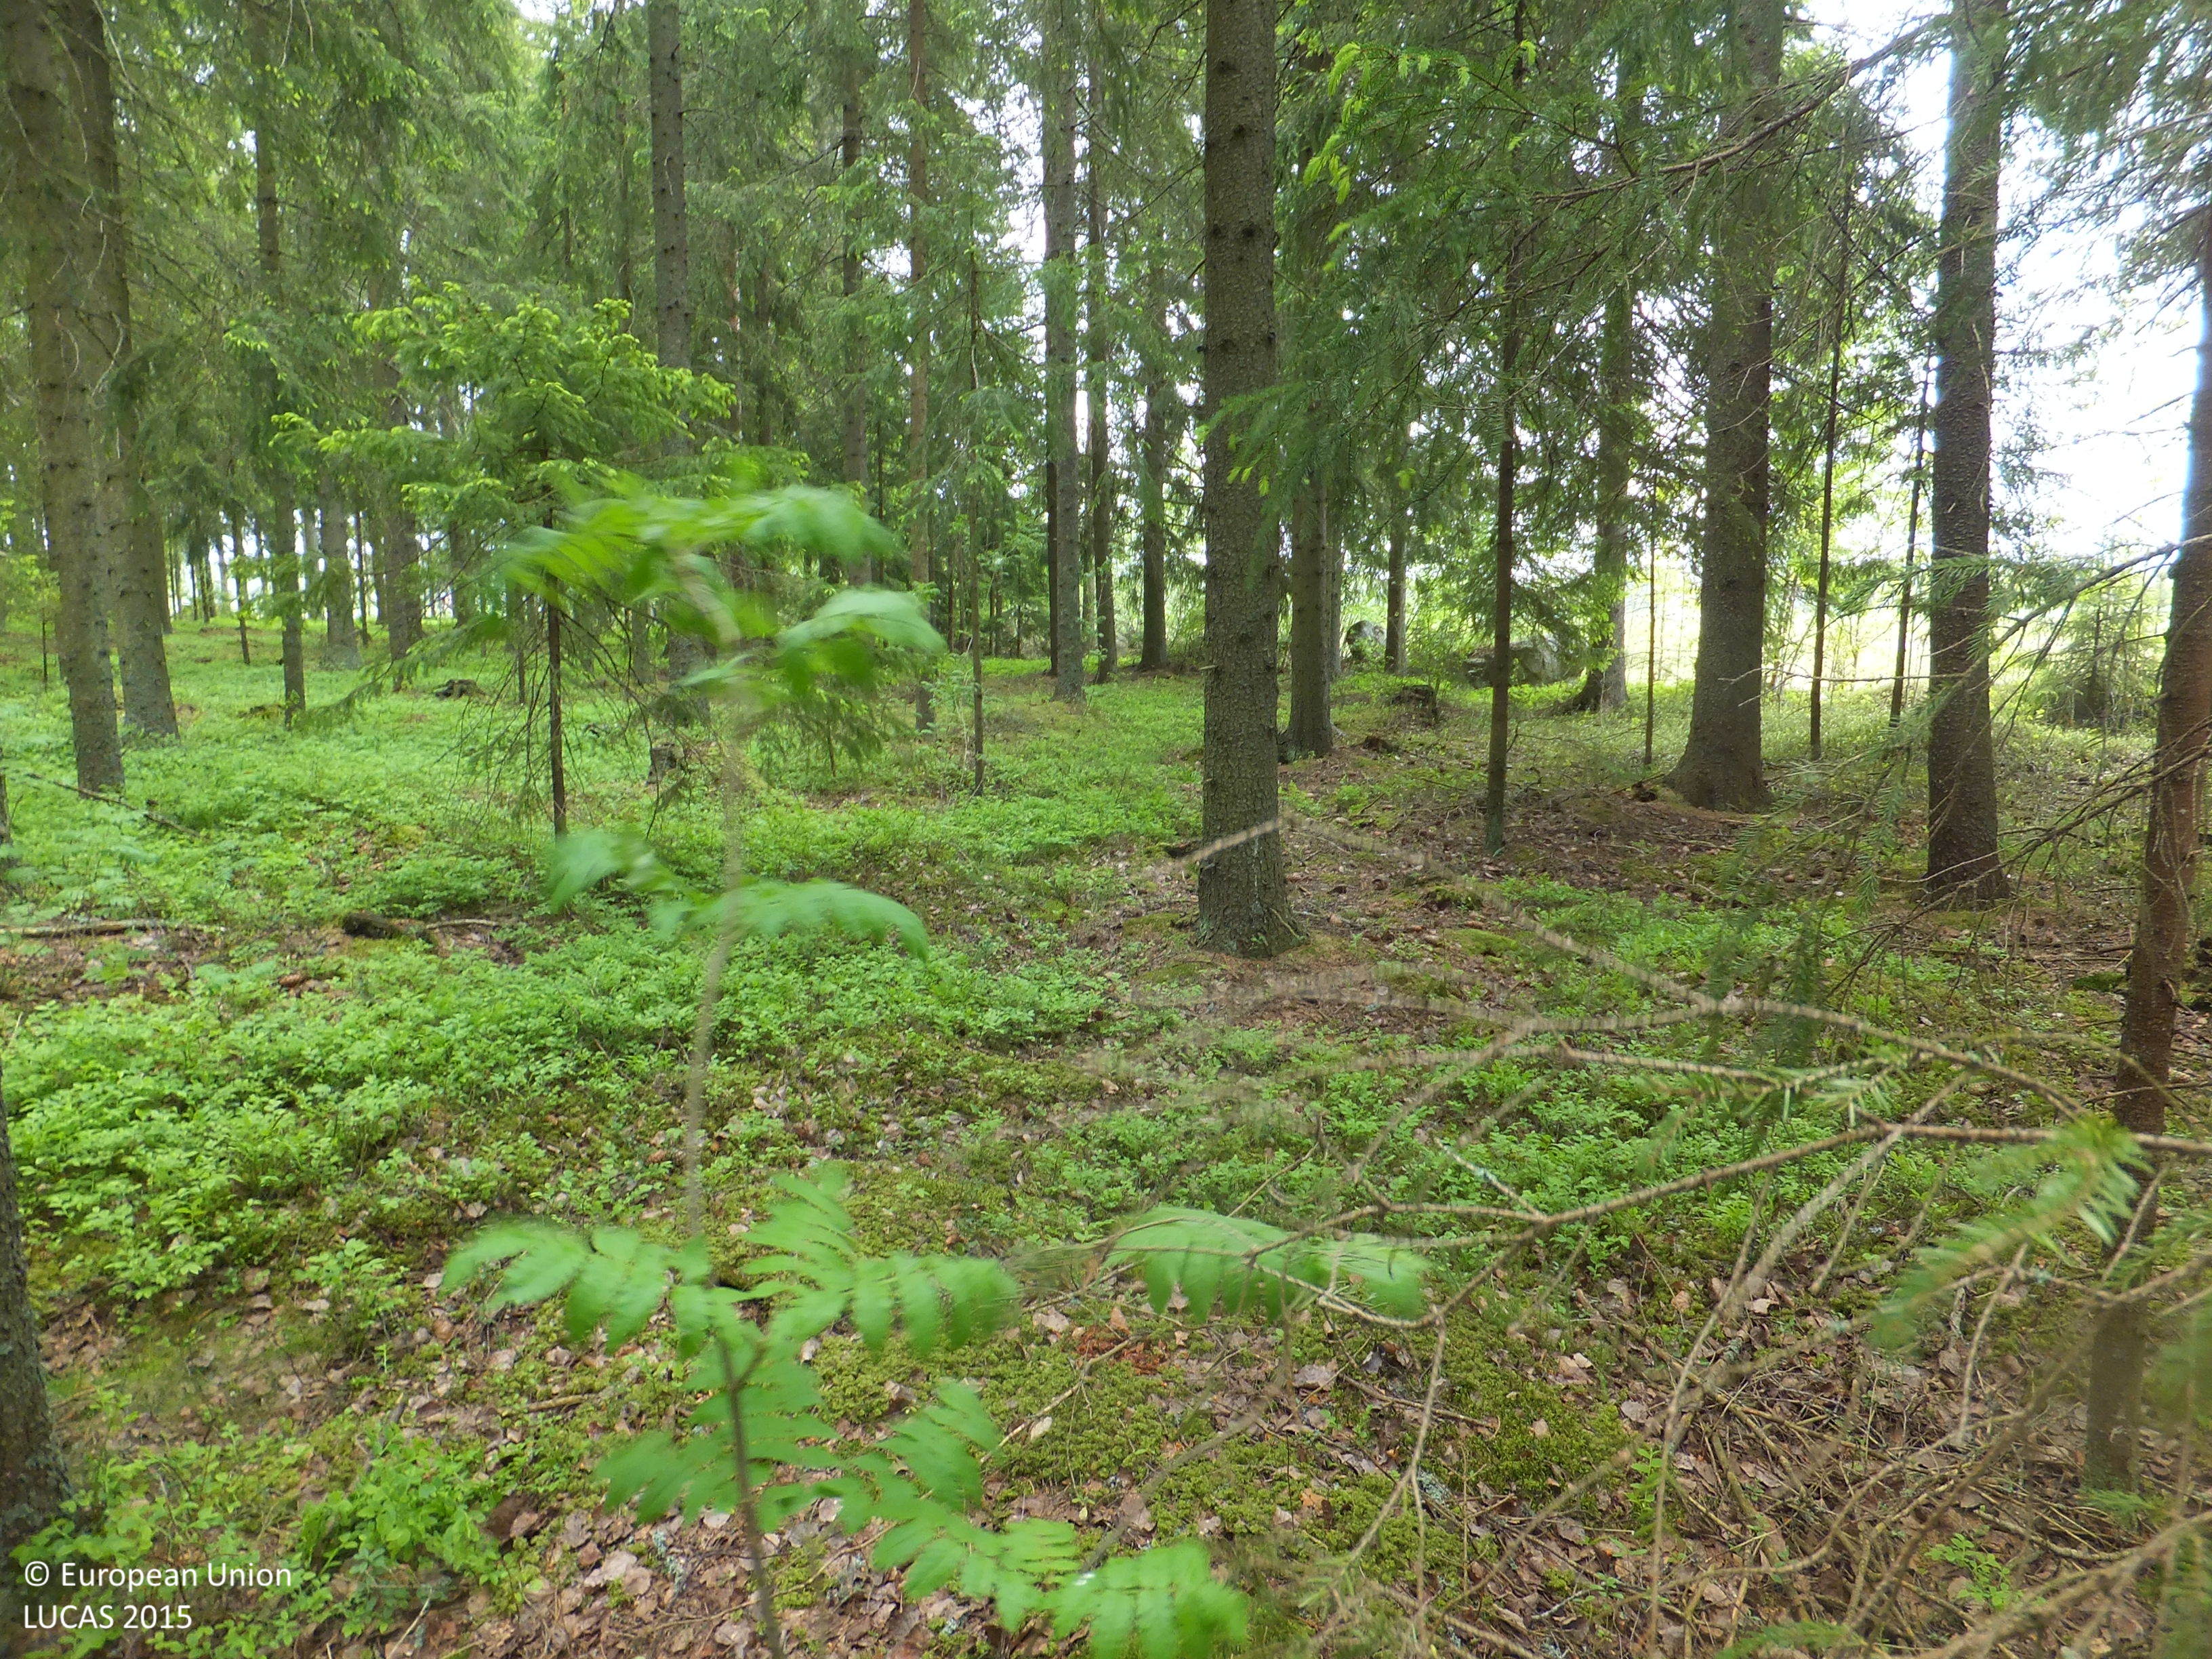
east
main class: Woodland
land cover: Spruce dominated mixed woodland
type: boreal forest
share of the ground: > 75 %
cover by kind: coniferous forest trees 55 %, broadleaved forest trees 20 %, shrubs 10 %, lichens and mosses 10 %, herbaceous plants 5 %
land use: Forestry
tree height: > 5 m
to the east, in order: Spruce dominated mixed woodland; Ditches and canals; Spontaneously vegetated surfaces; Other bare soil; Ditches and canals; Tracks; Ditches and canals; Other bare soil
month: June
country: FI
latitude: 63.1866
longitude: 22.5089
